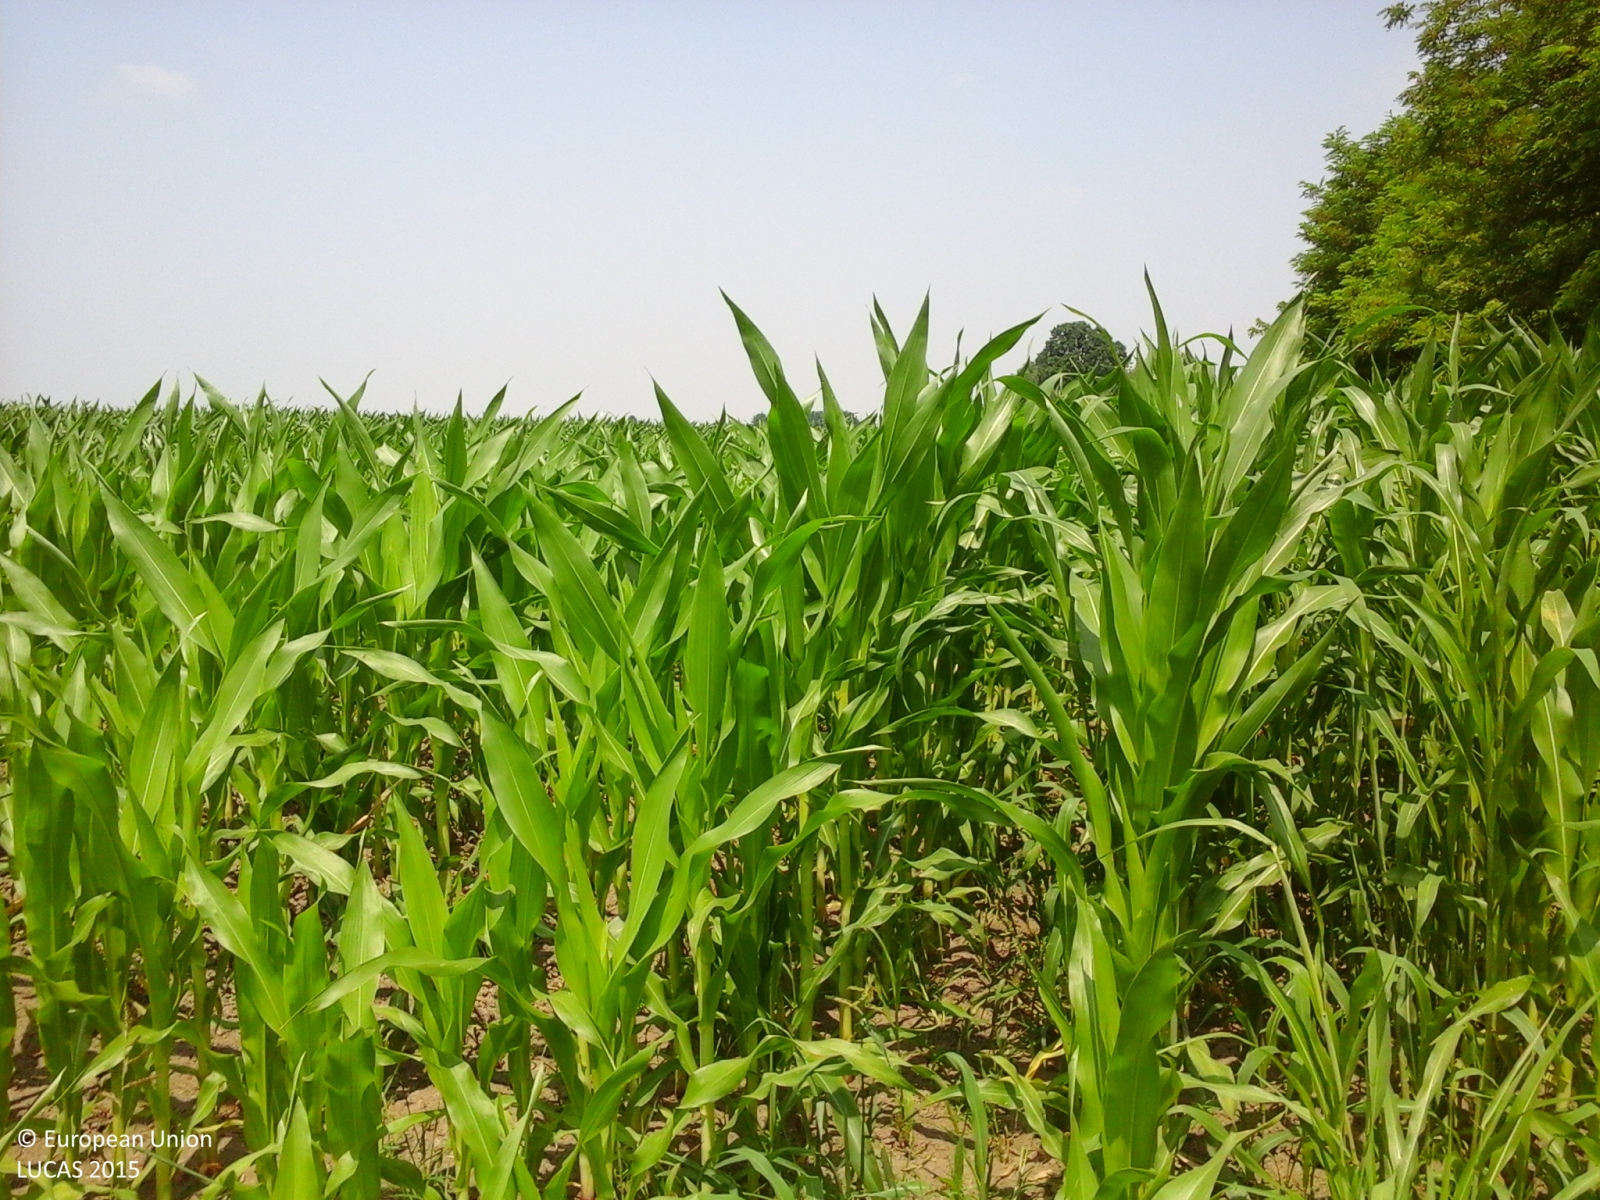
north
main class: Cropland
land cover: Maize
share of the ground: > 75 %
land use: Agriculture (excluding fallow land and kitchen gardens)
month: June
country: IT
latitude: 44.9816
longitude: 9.9114
